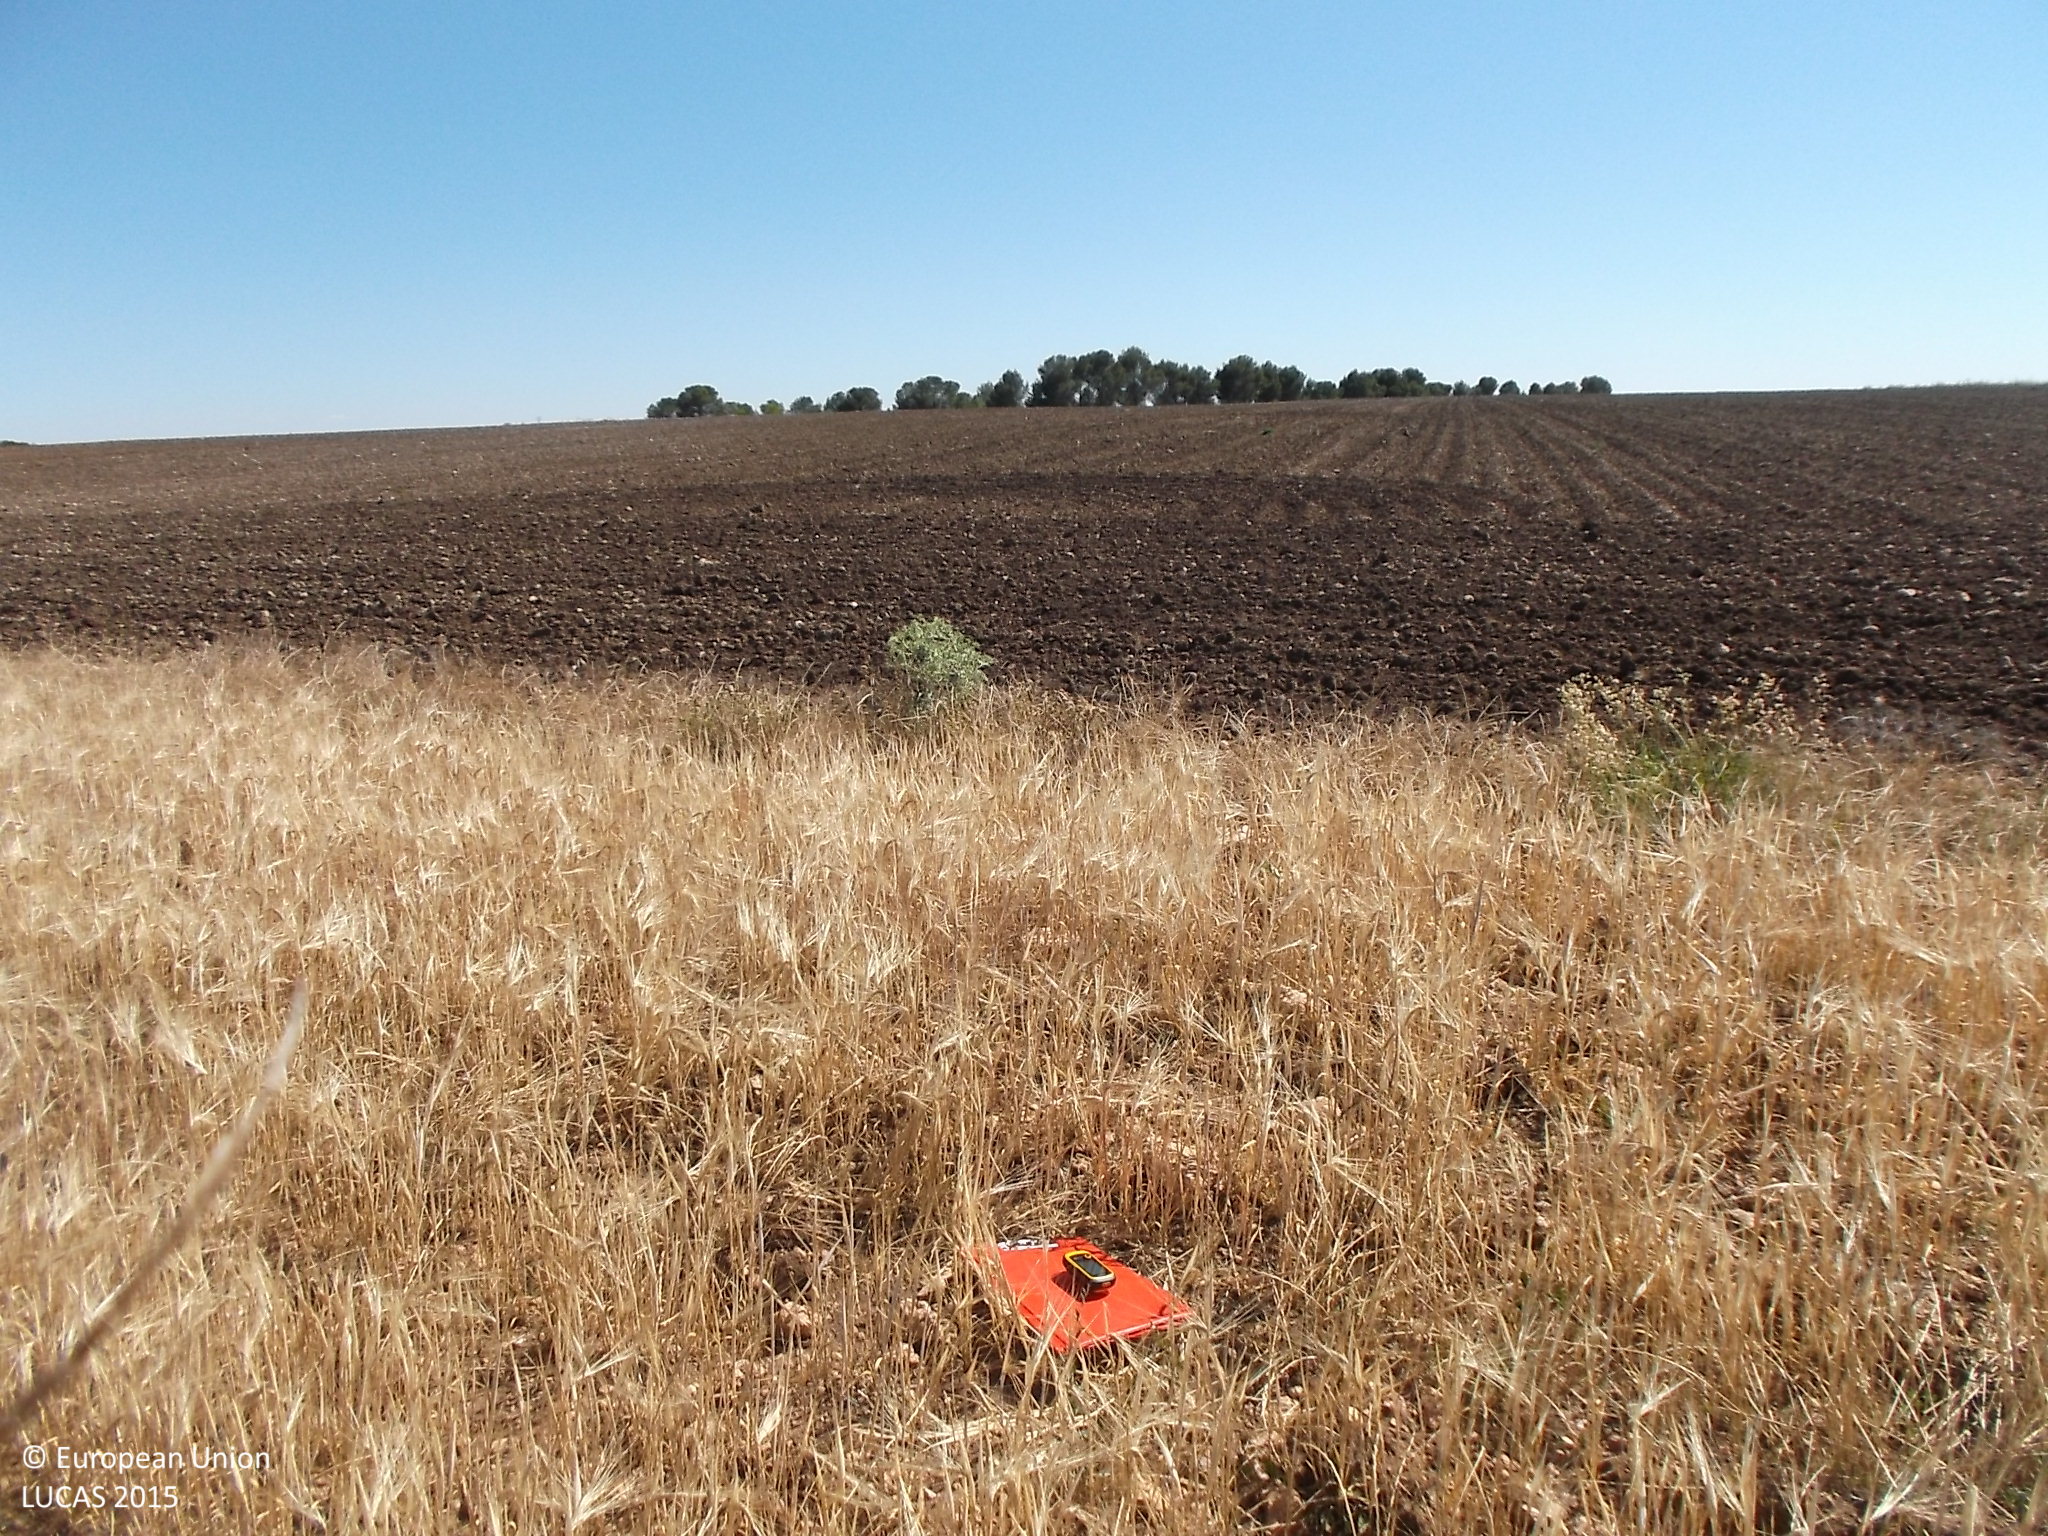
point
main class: Cropland
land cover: Barley
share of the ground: > 75 %
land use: Agriculture (excluding fallow land and kitchen gardens)
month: June
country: ES
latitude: 41.3705
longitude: -5.3197
